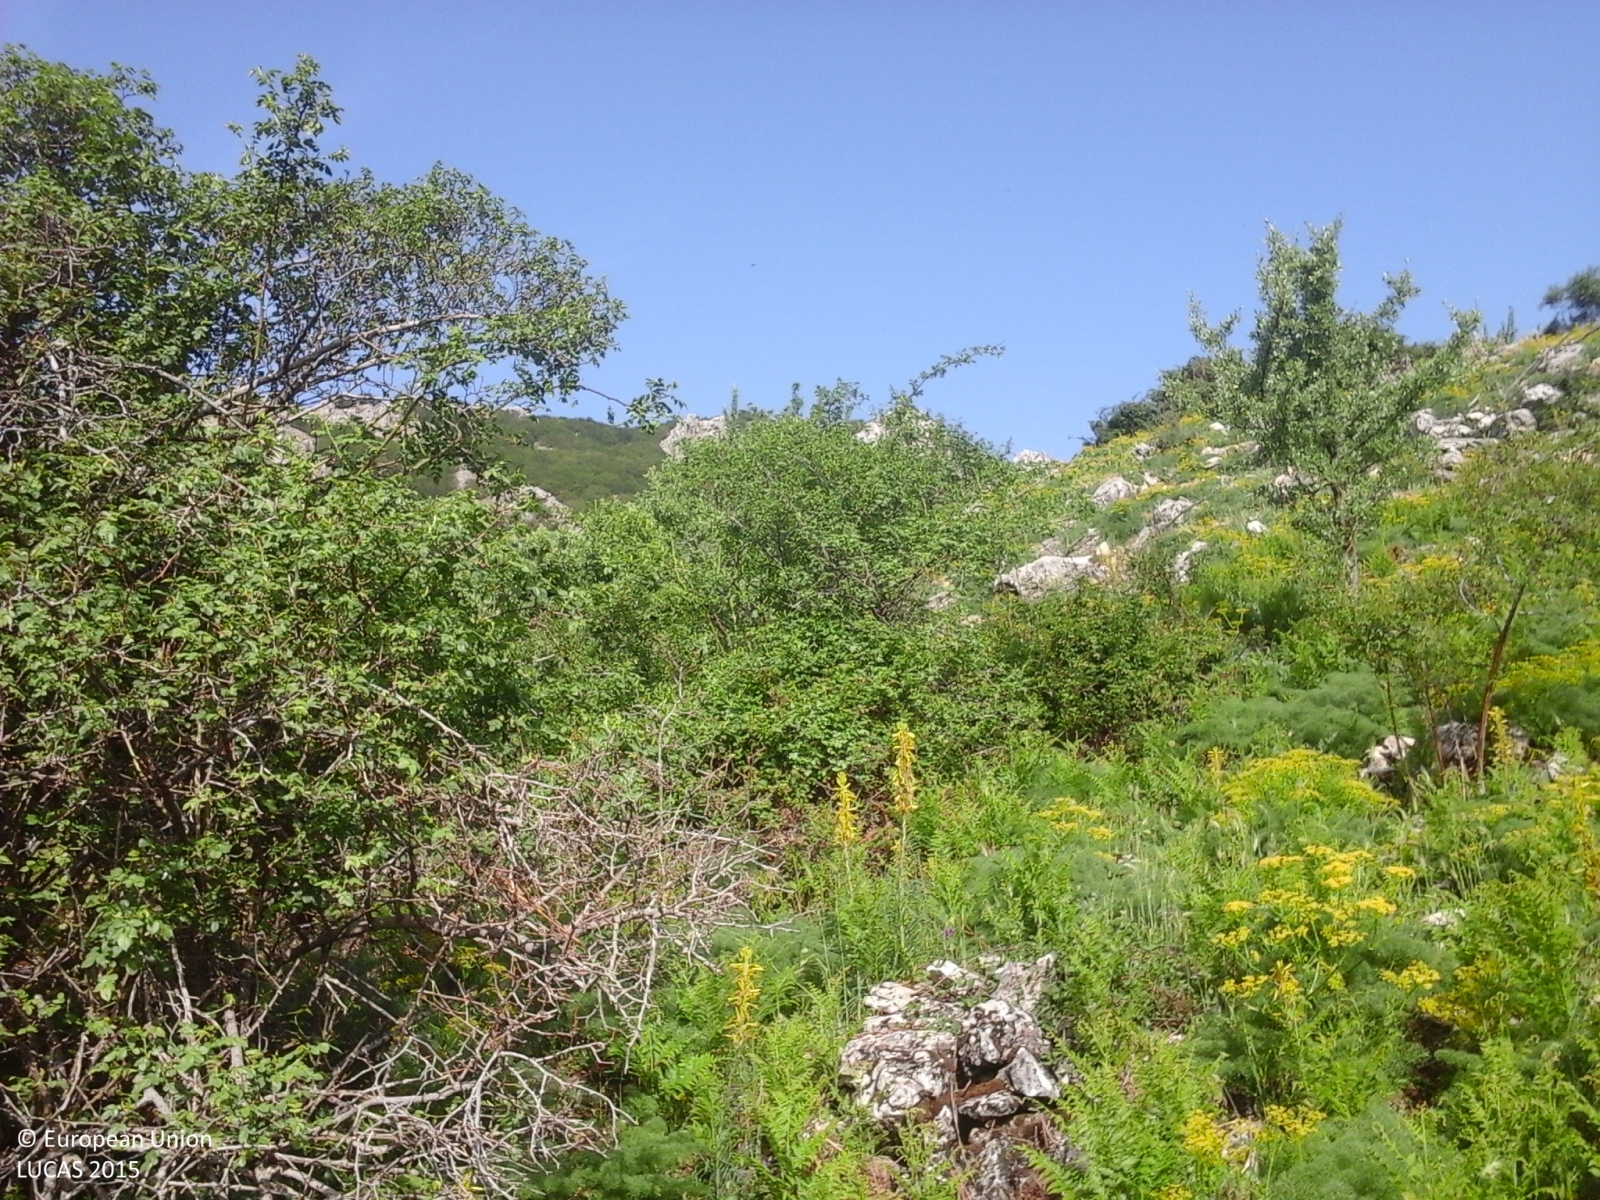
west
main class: Grassland
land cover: Grassland with sparse tree/shrub cover
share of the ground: > 75 %
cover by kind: herbaceous plants 70 %, consolidated bare surface 15 %, shrubs 10 %, broadleaved forest trees 5 %
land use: Agriculture (excluding fallow land and kitchen gardens)
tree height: < 5 m
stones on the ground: 25 - 50 %
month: May
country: IT
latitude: 37.8611
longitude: 14.0519
